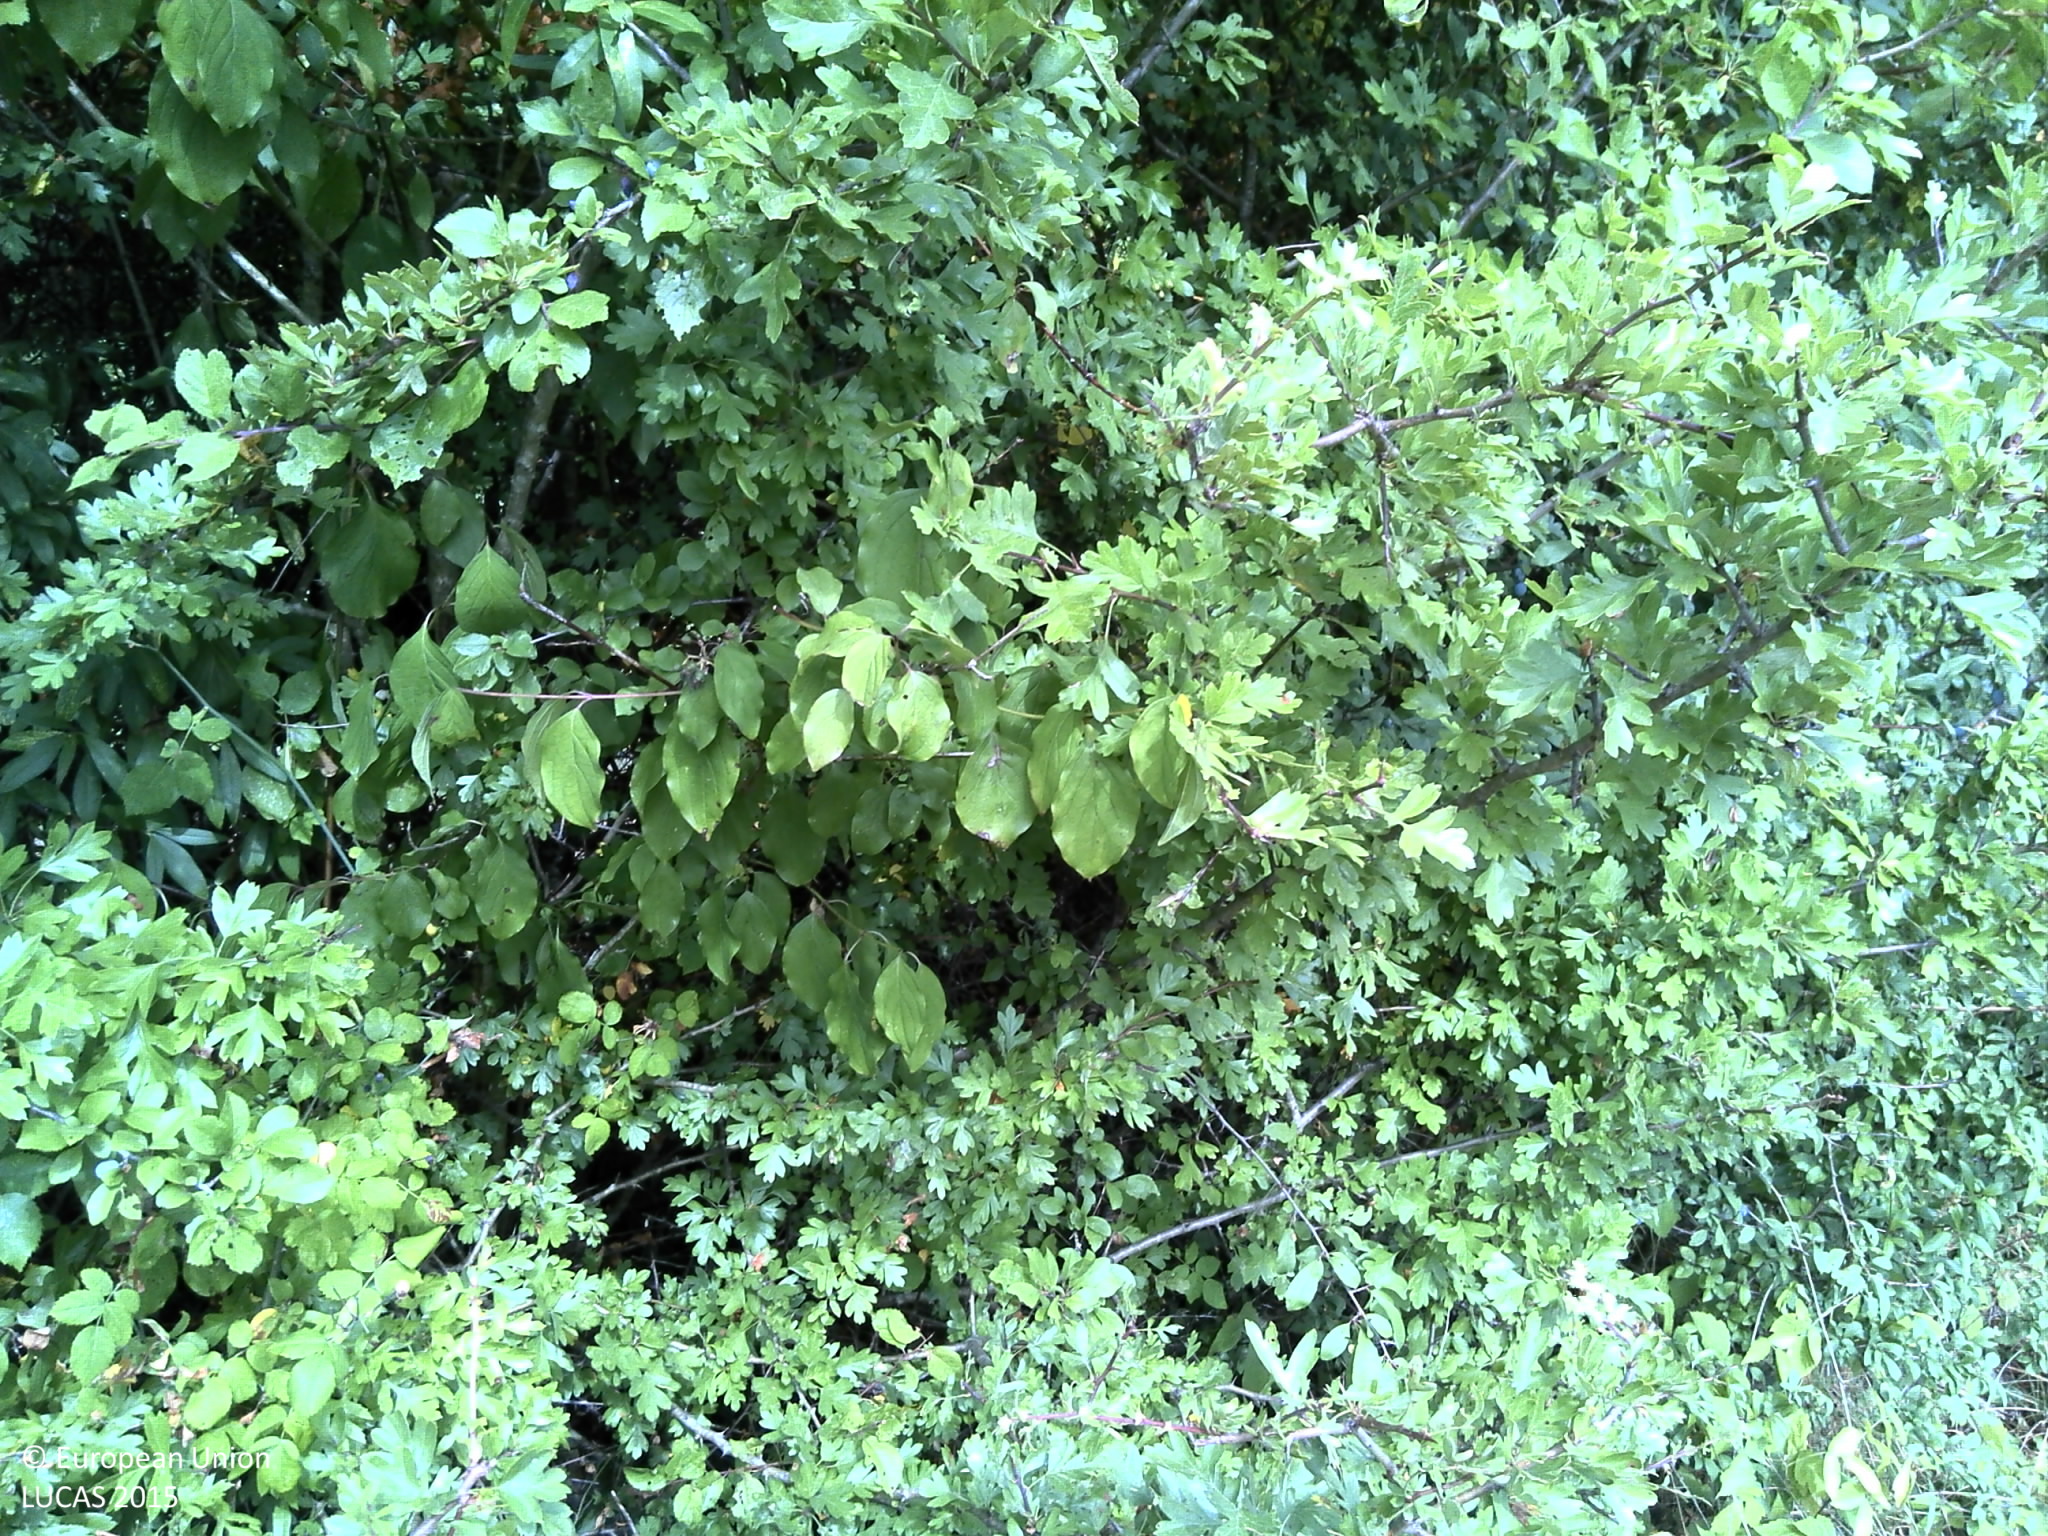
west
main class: Grassland
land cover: Grassland without tree/shrub cover
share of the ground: > 75 %
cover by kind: herbaceous plants 100 %
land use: Agriculture (excluding fallow land and kitchen gardens)
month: July
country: FR
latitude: 48.1192
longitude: 6.1183
